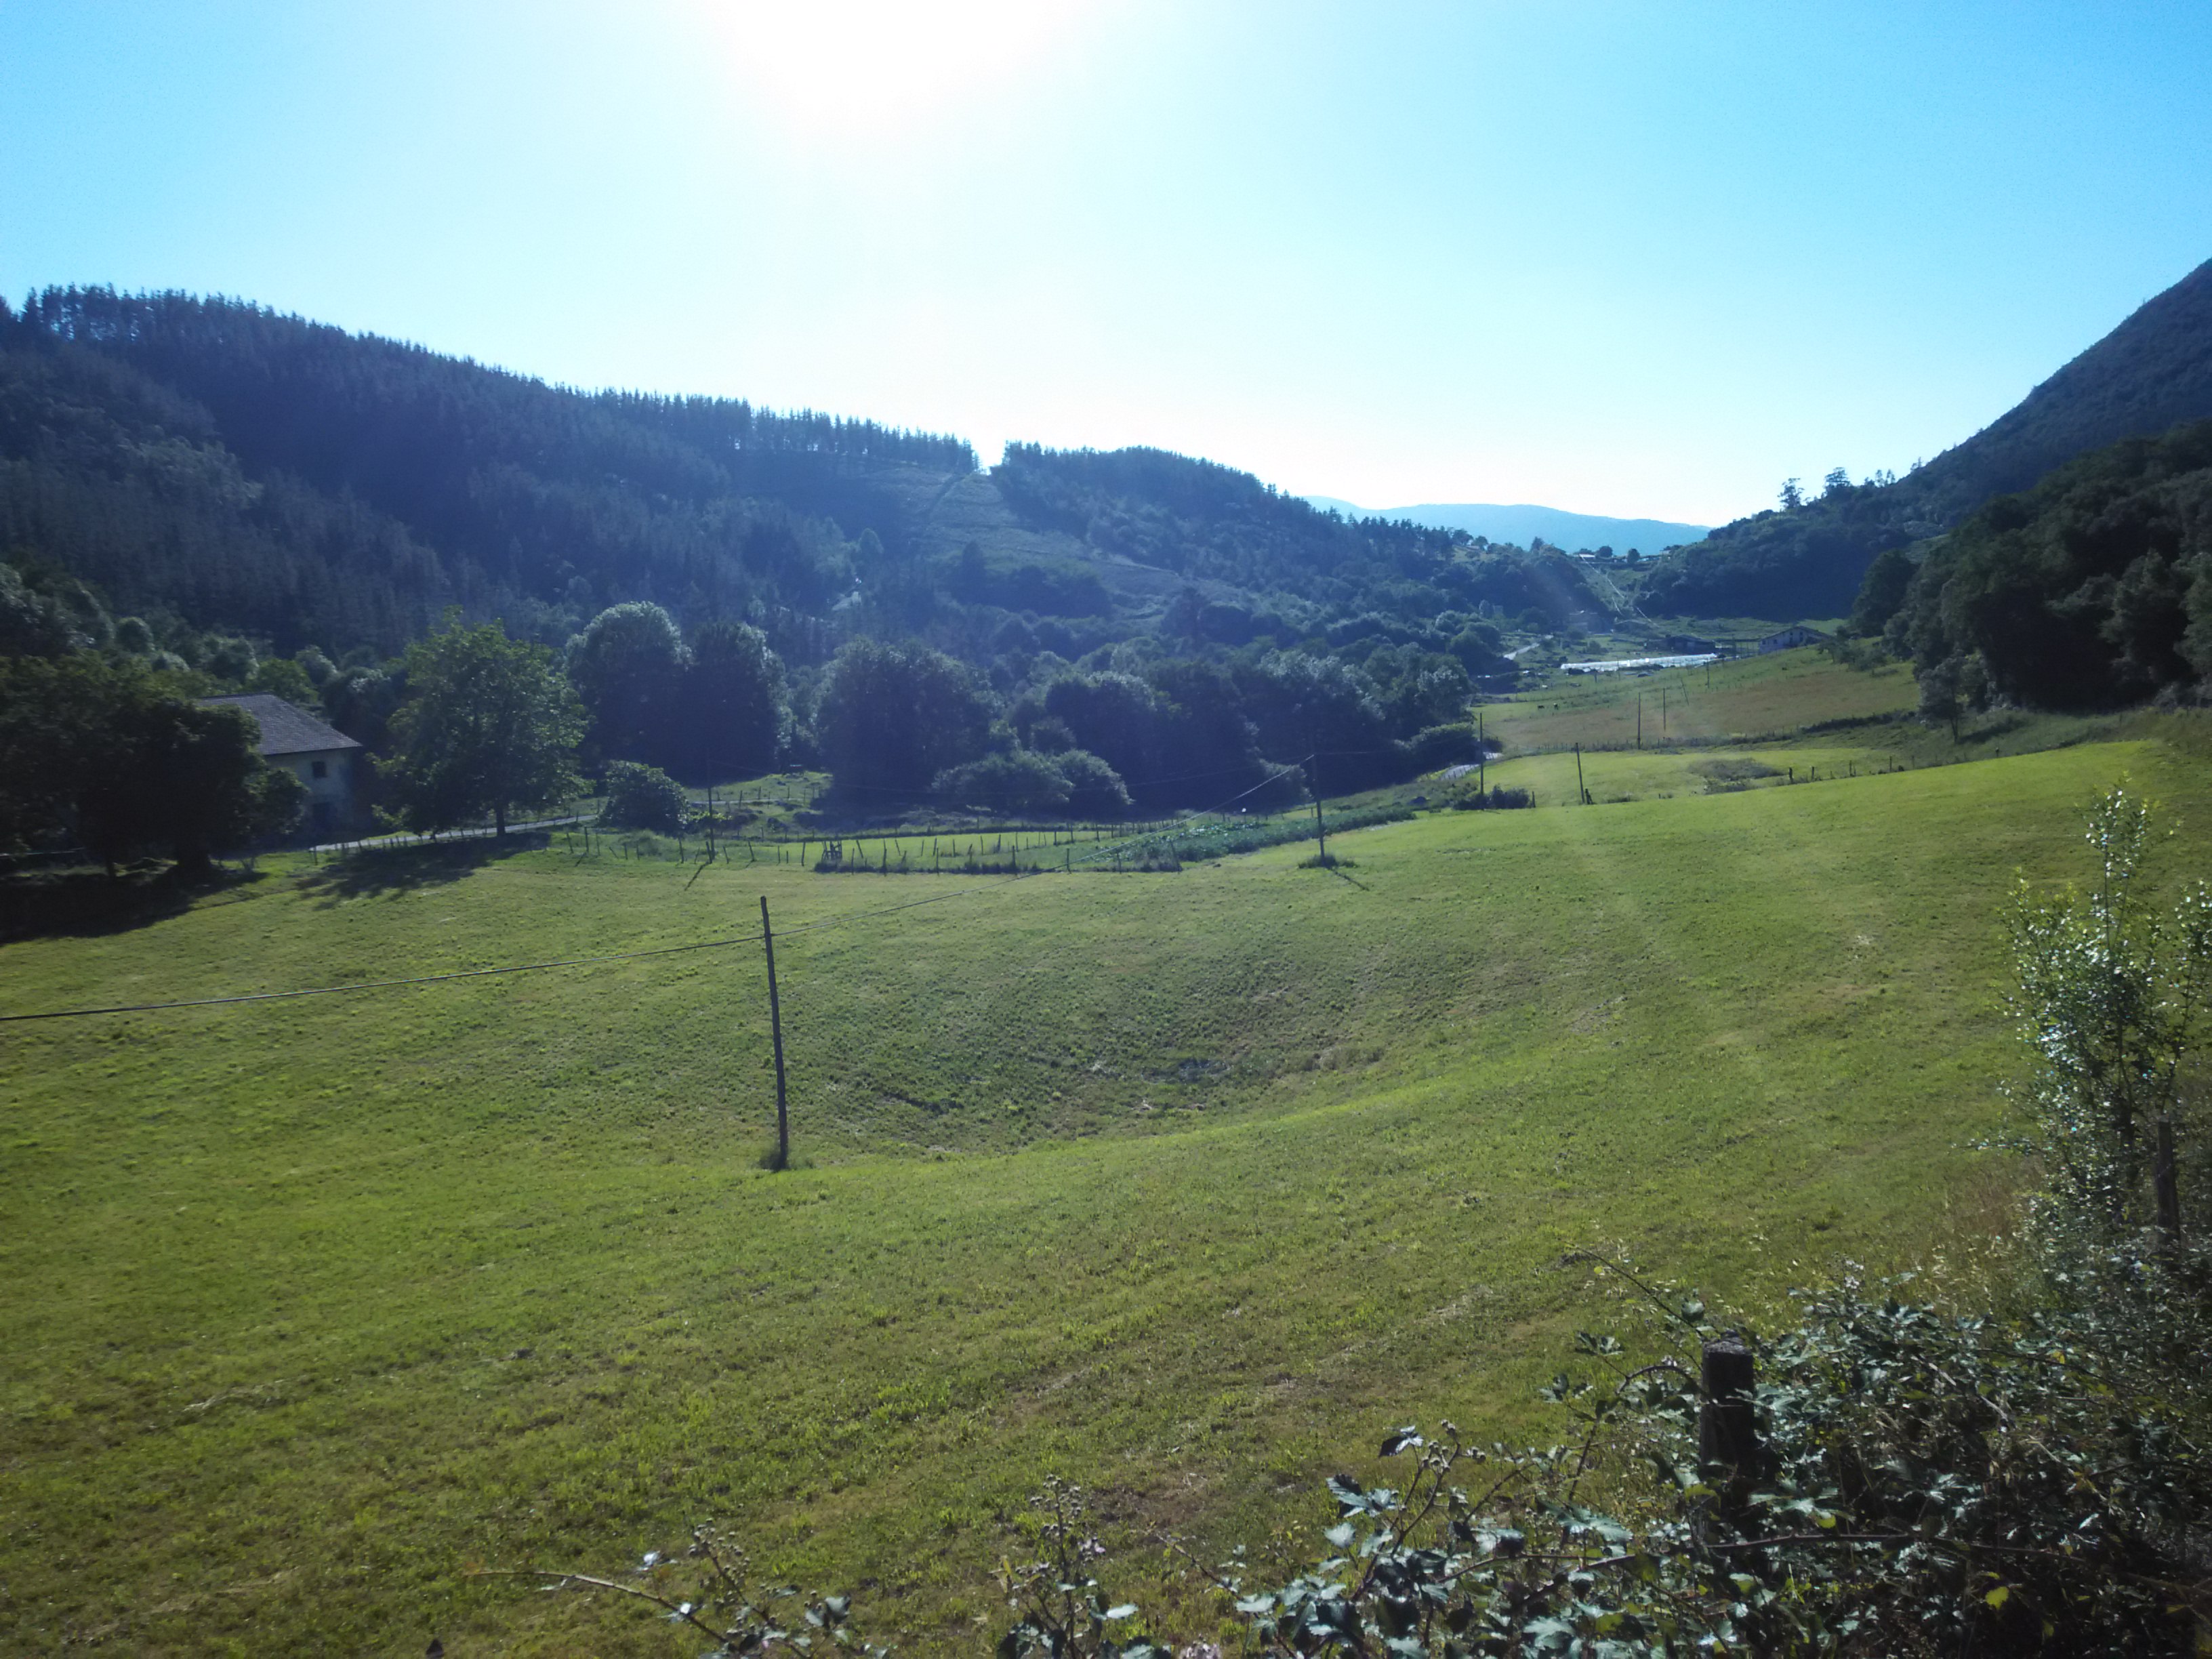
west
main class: Grassland
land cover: Grassland without tree/shrub cover
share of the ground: > 75 %
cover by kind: herbaceous plants 85 %, shrubs 5 %
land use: Agriculture (excluding fallow land and kitchen gardens)
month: June
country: ES
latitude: 43.3390
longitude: -2.6244
